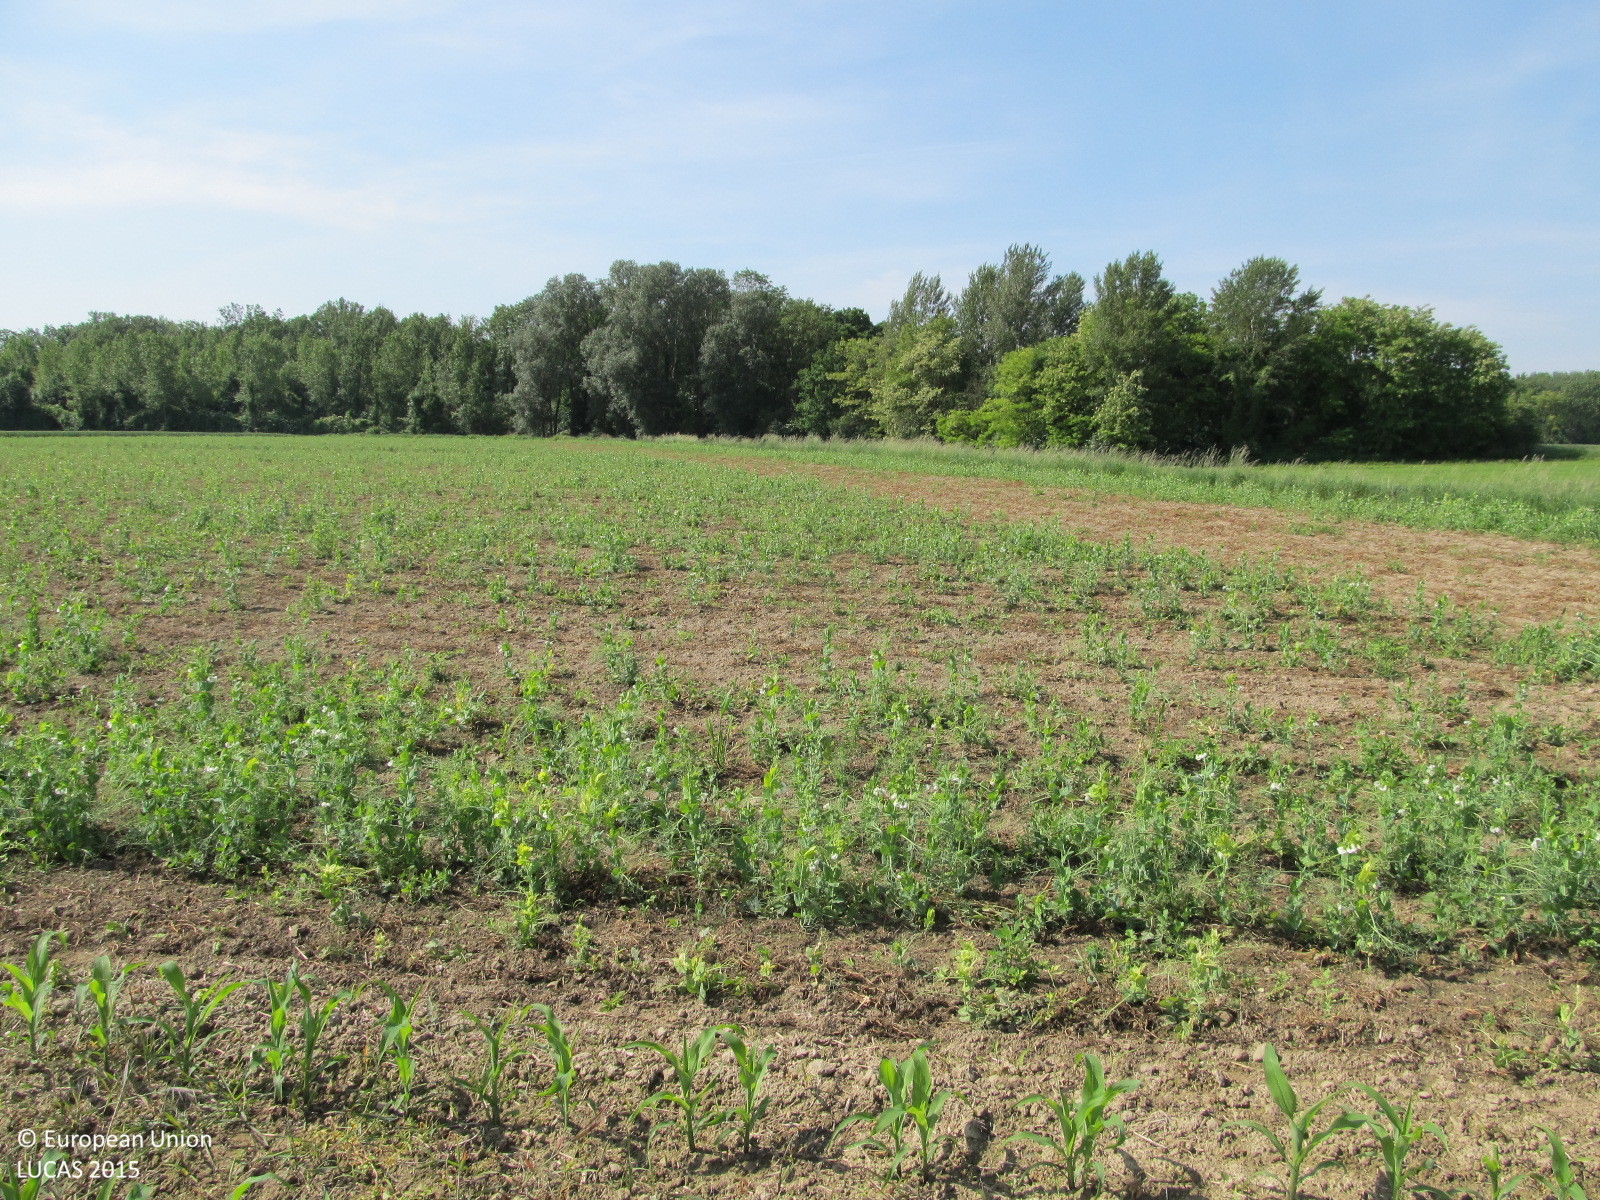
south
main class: Cropland
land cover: Maize
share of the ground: < 10 %
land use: Agriculture (excluding fallow land and kitchen gardens)
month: May
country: AT
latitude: 48.3929
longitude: 15.8514
